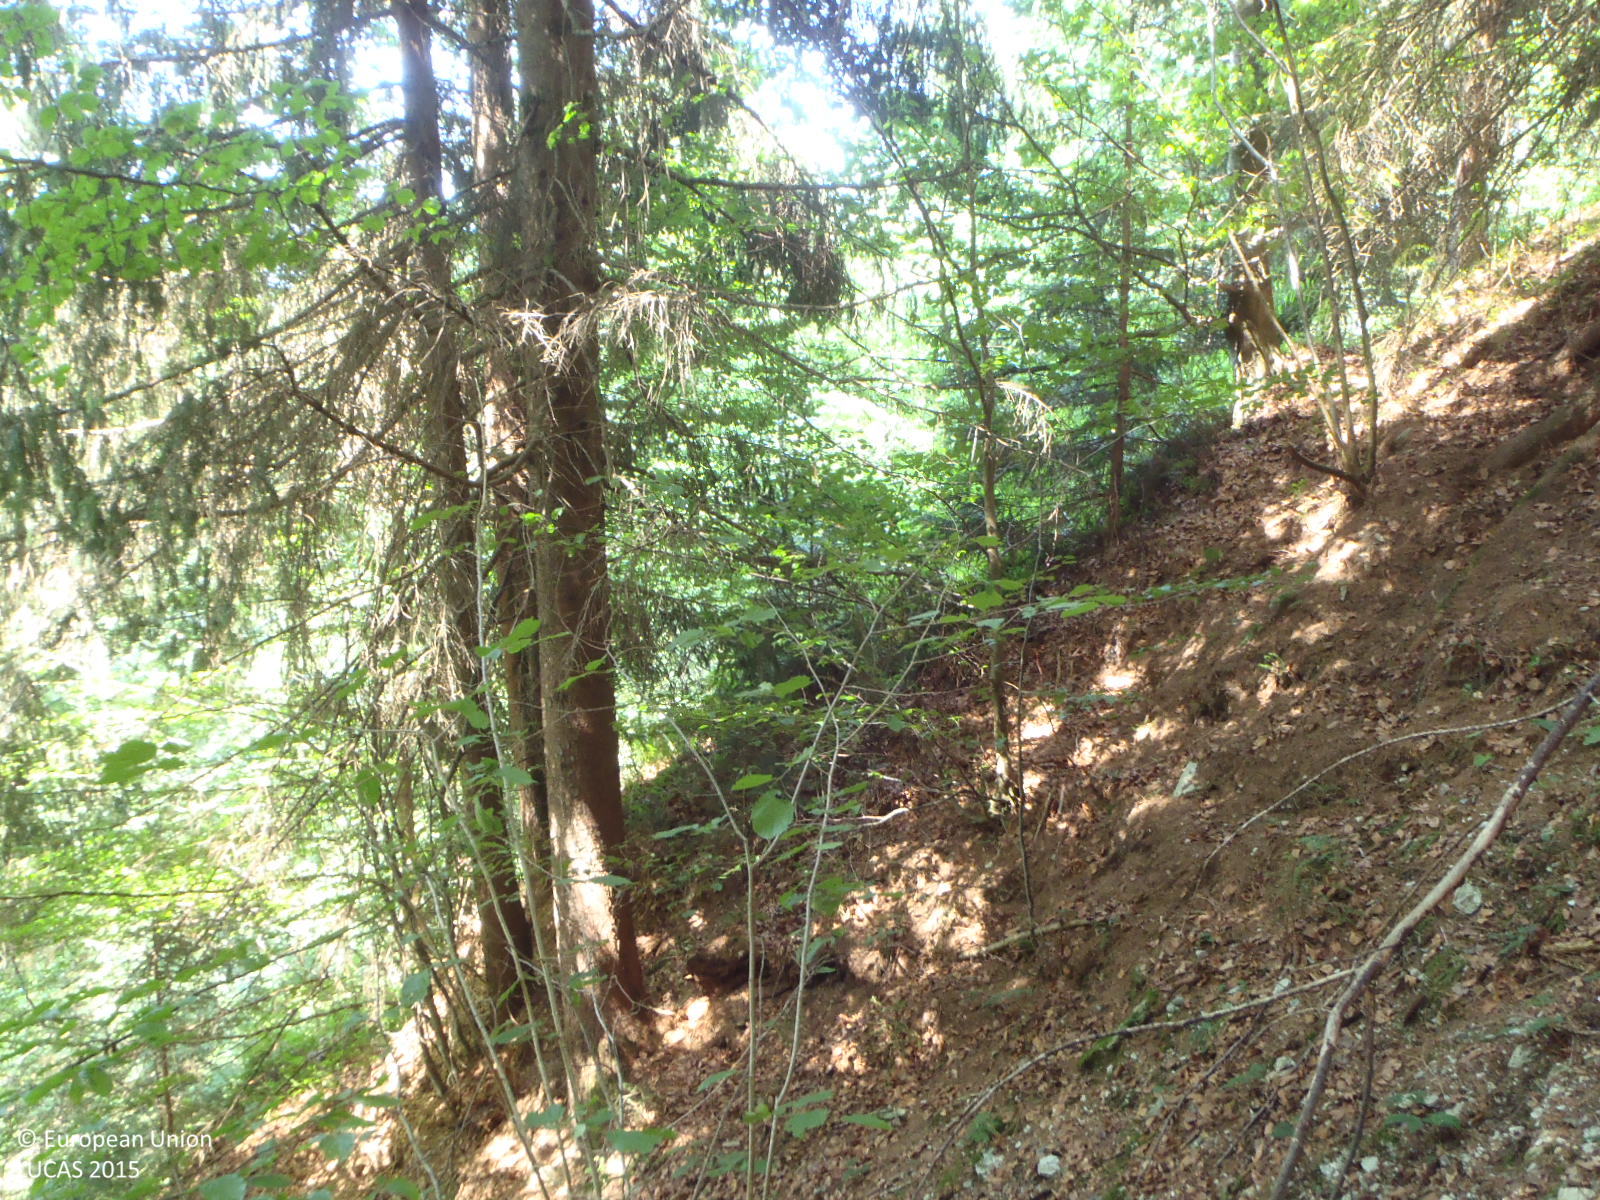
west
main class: Woodland
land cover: Spruce dominated mixed woodland
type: alpine coniferous forest
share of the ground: > 75 %
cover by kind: coniferous forest trees 60 %, broadleaved forest trees 30 %, shrubs 10 %
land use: Forestry
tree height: > 5 m
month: July
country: AT
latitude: 47.4592
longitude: 12.3993
